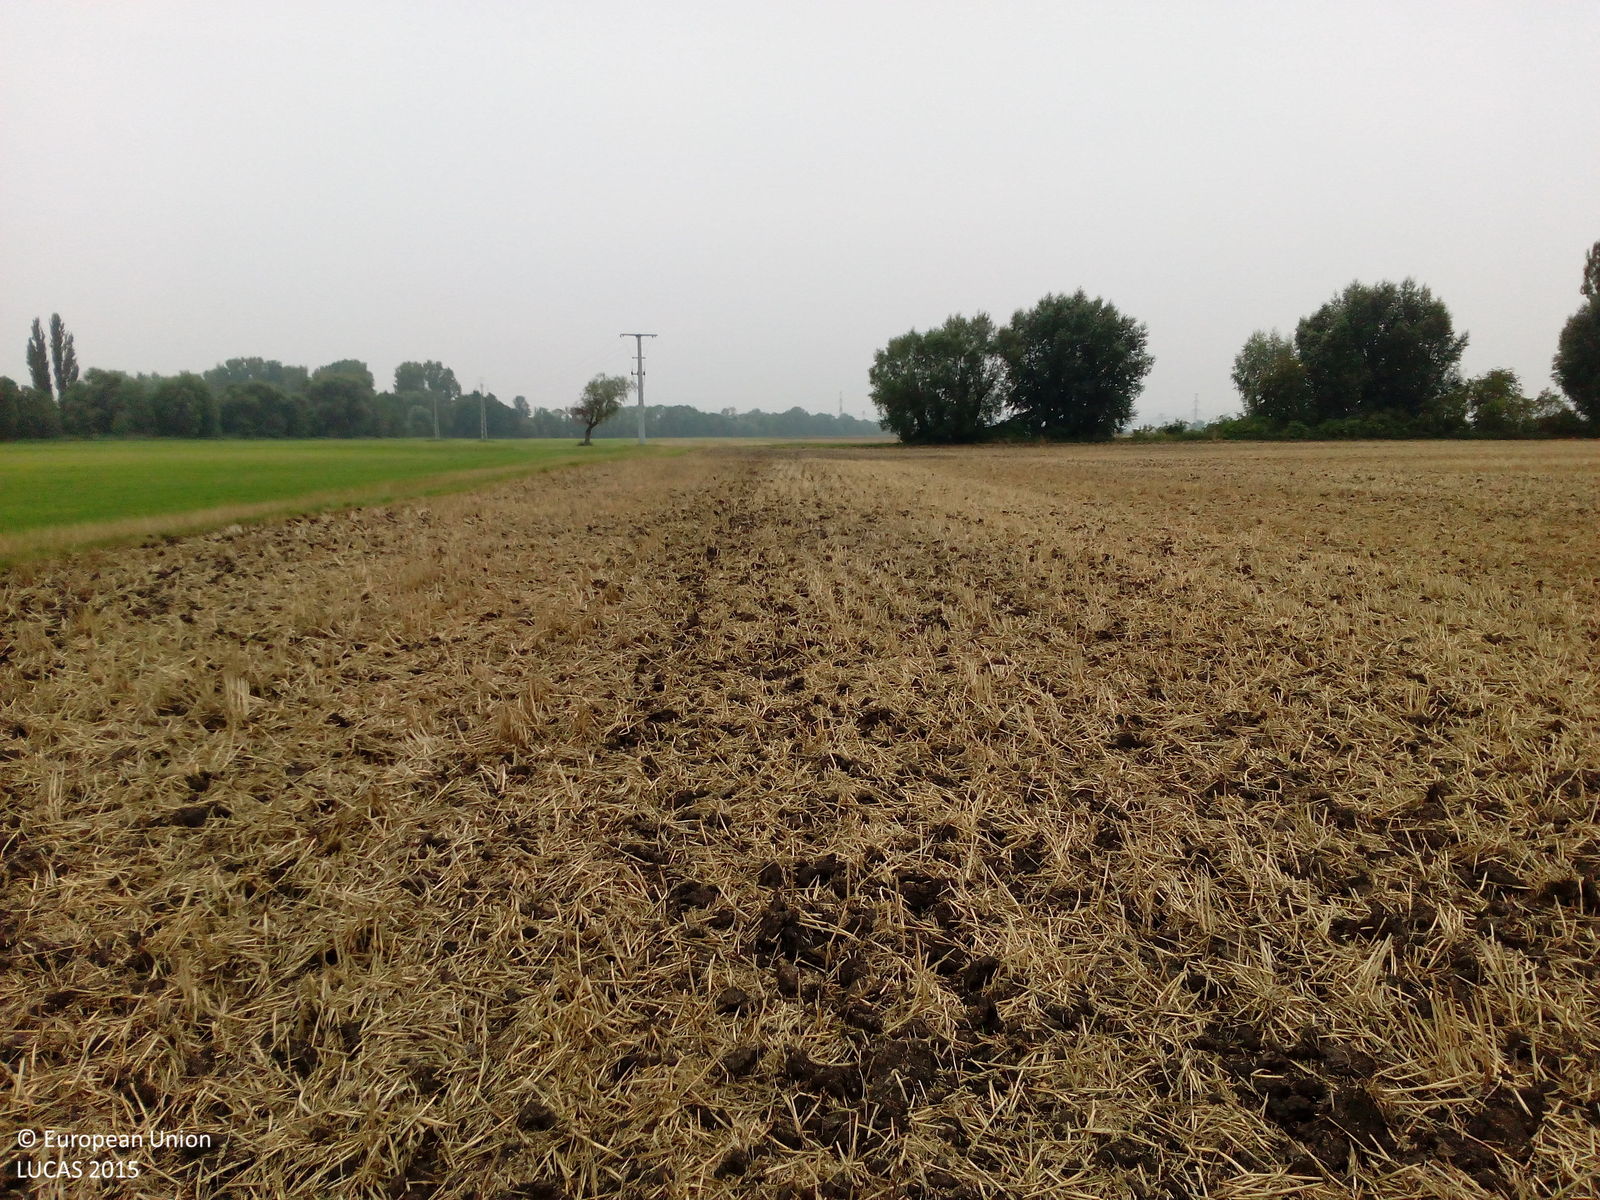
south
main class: Cropland
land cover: Common wheat
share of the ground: 50 - 75 %
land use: Agriculture (excluding fallow land and kitchen gardens)
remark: Harvested field
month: August
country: DE
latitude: 51.0608
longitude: 11.0128
